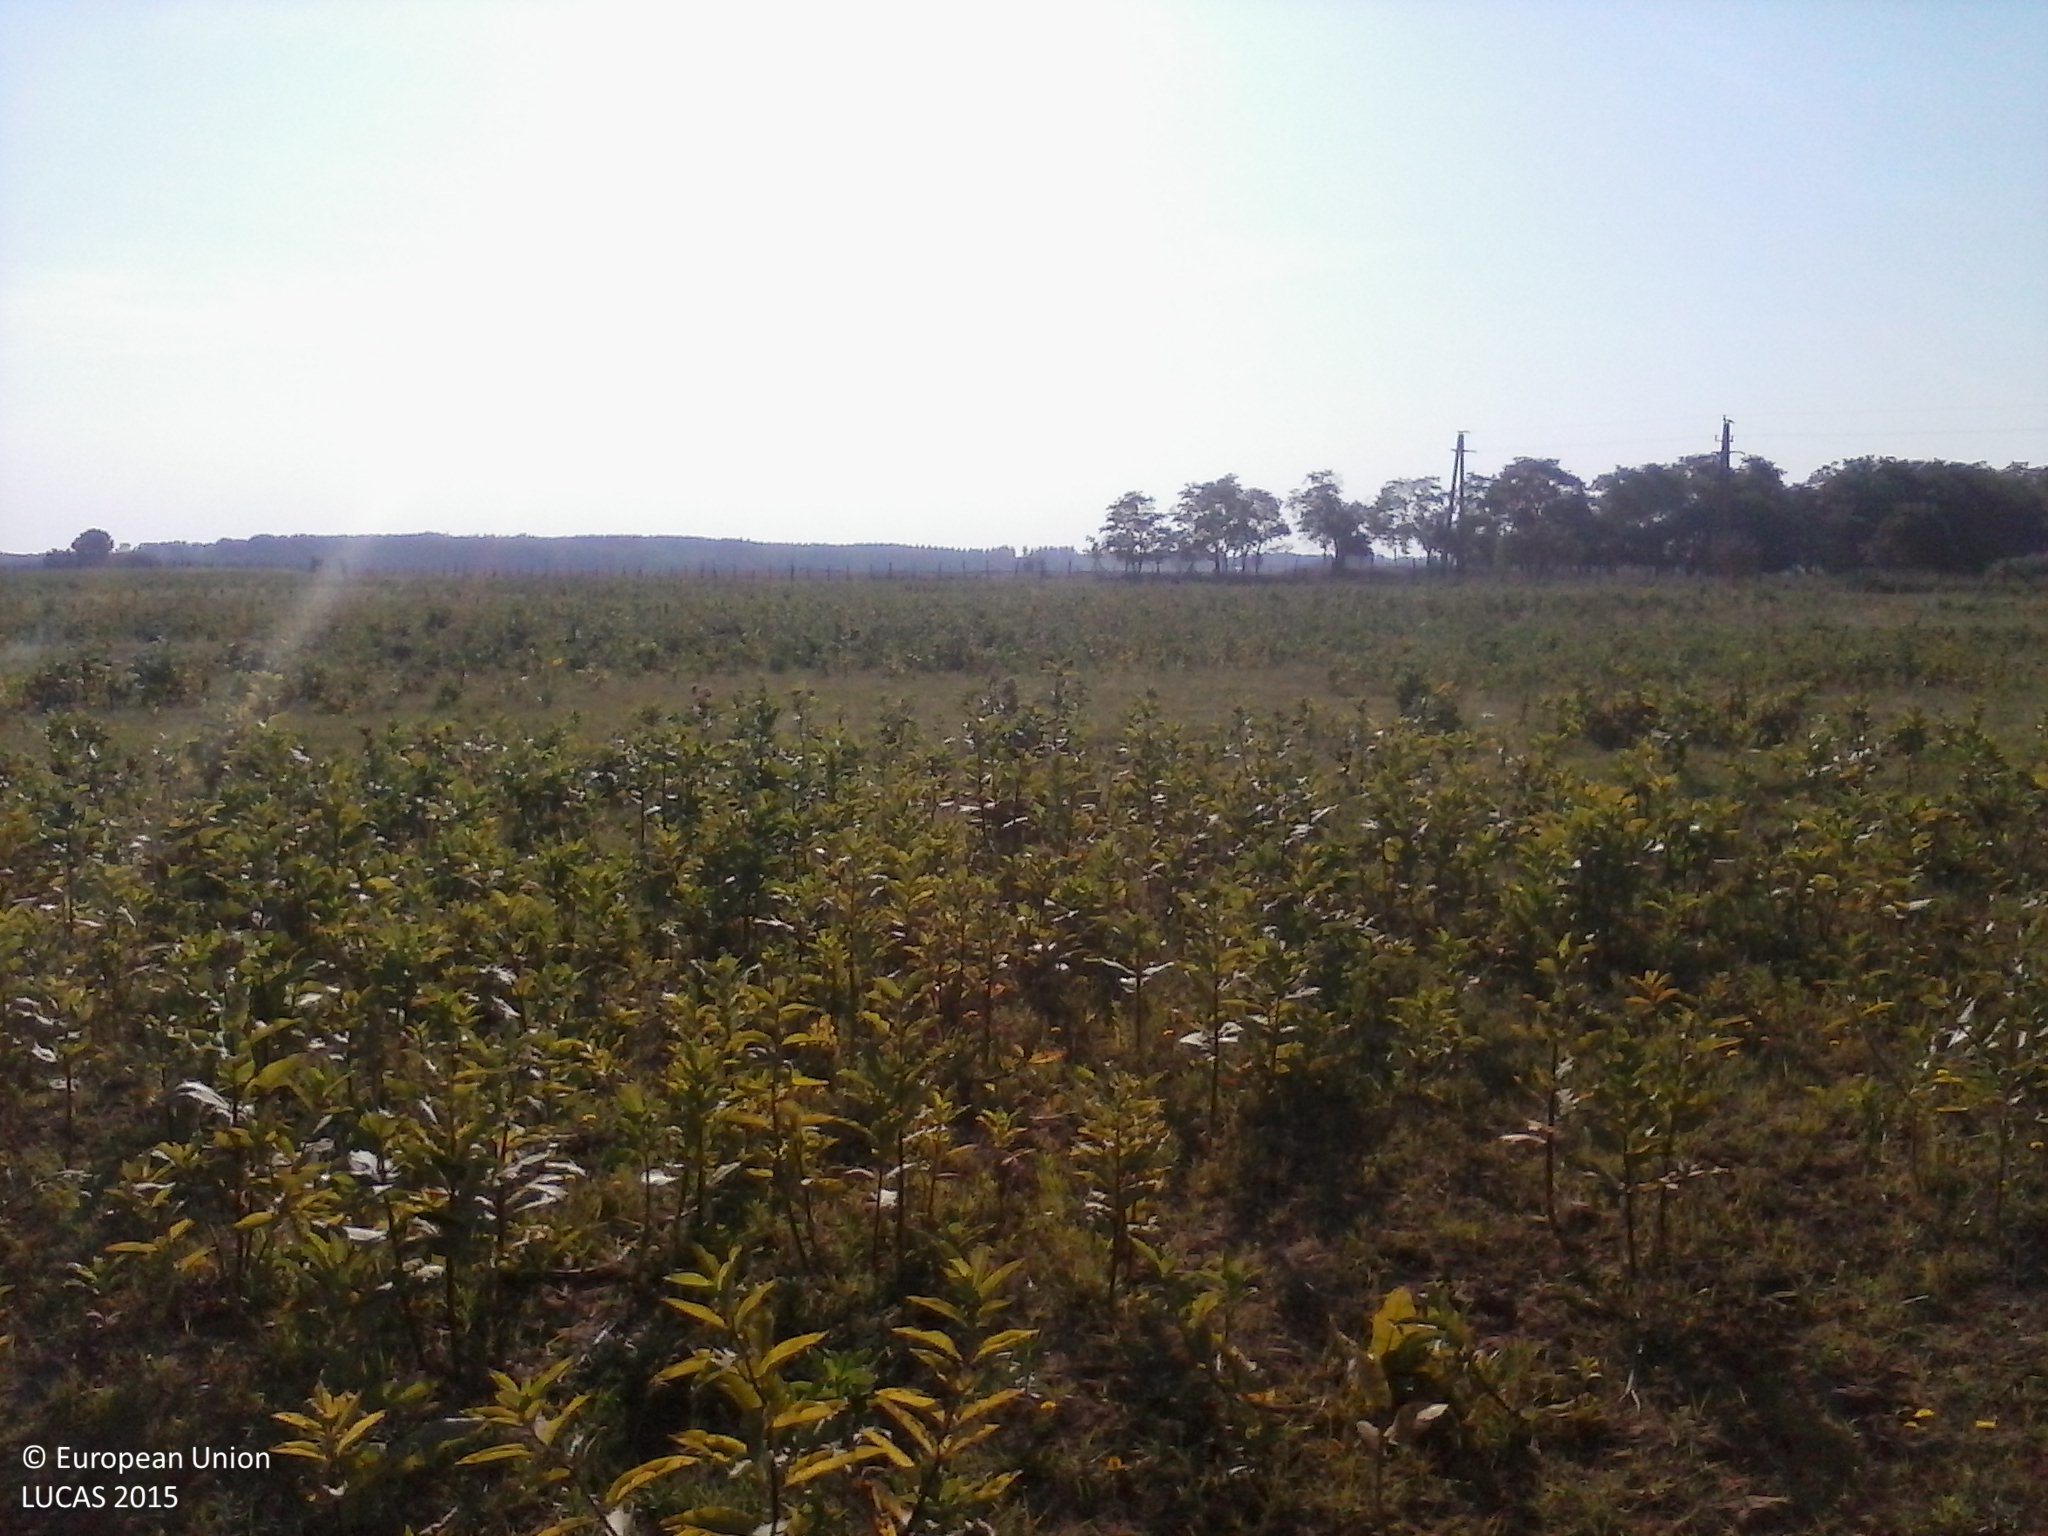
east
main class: Grassland
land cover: Spontaneously vegetated surfaces
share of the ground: > 75 %
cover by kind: herbaceous plants 90 %, unconsolidated bare surface 10 %
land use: Agriculture (excluding fallow land and kitchen gardens)
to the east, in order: Spontaneously vegetated surfaces; Fences; Abandoned hedges; Grassland without tree/shrub cover
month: July
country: HU
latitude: 46.3339
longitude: 19.6179
